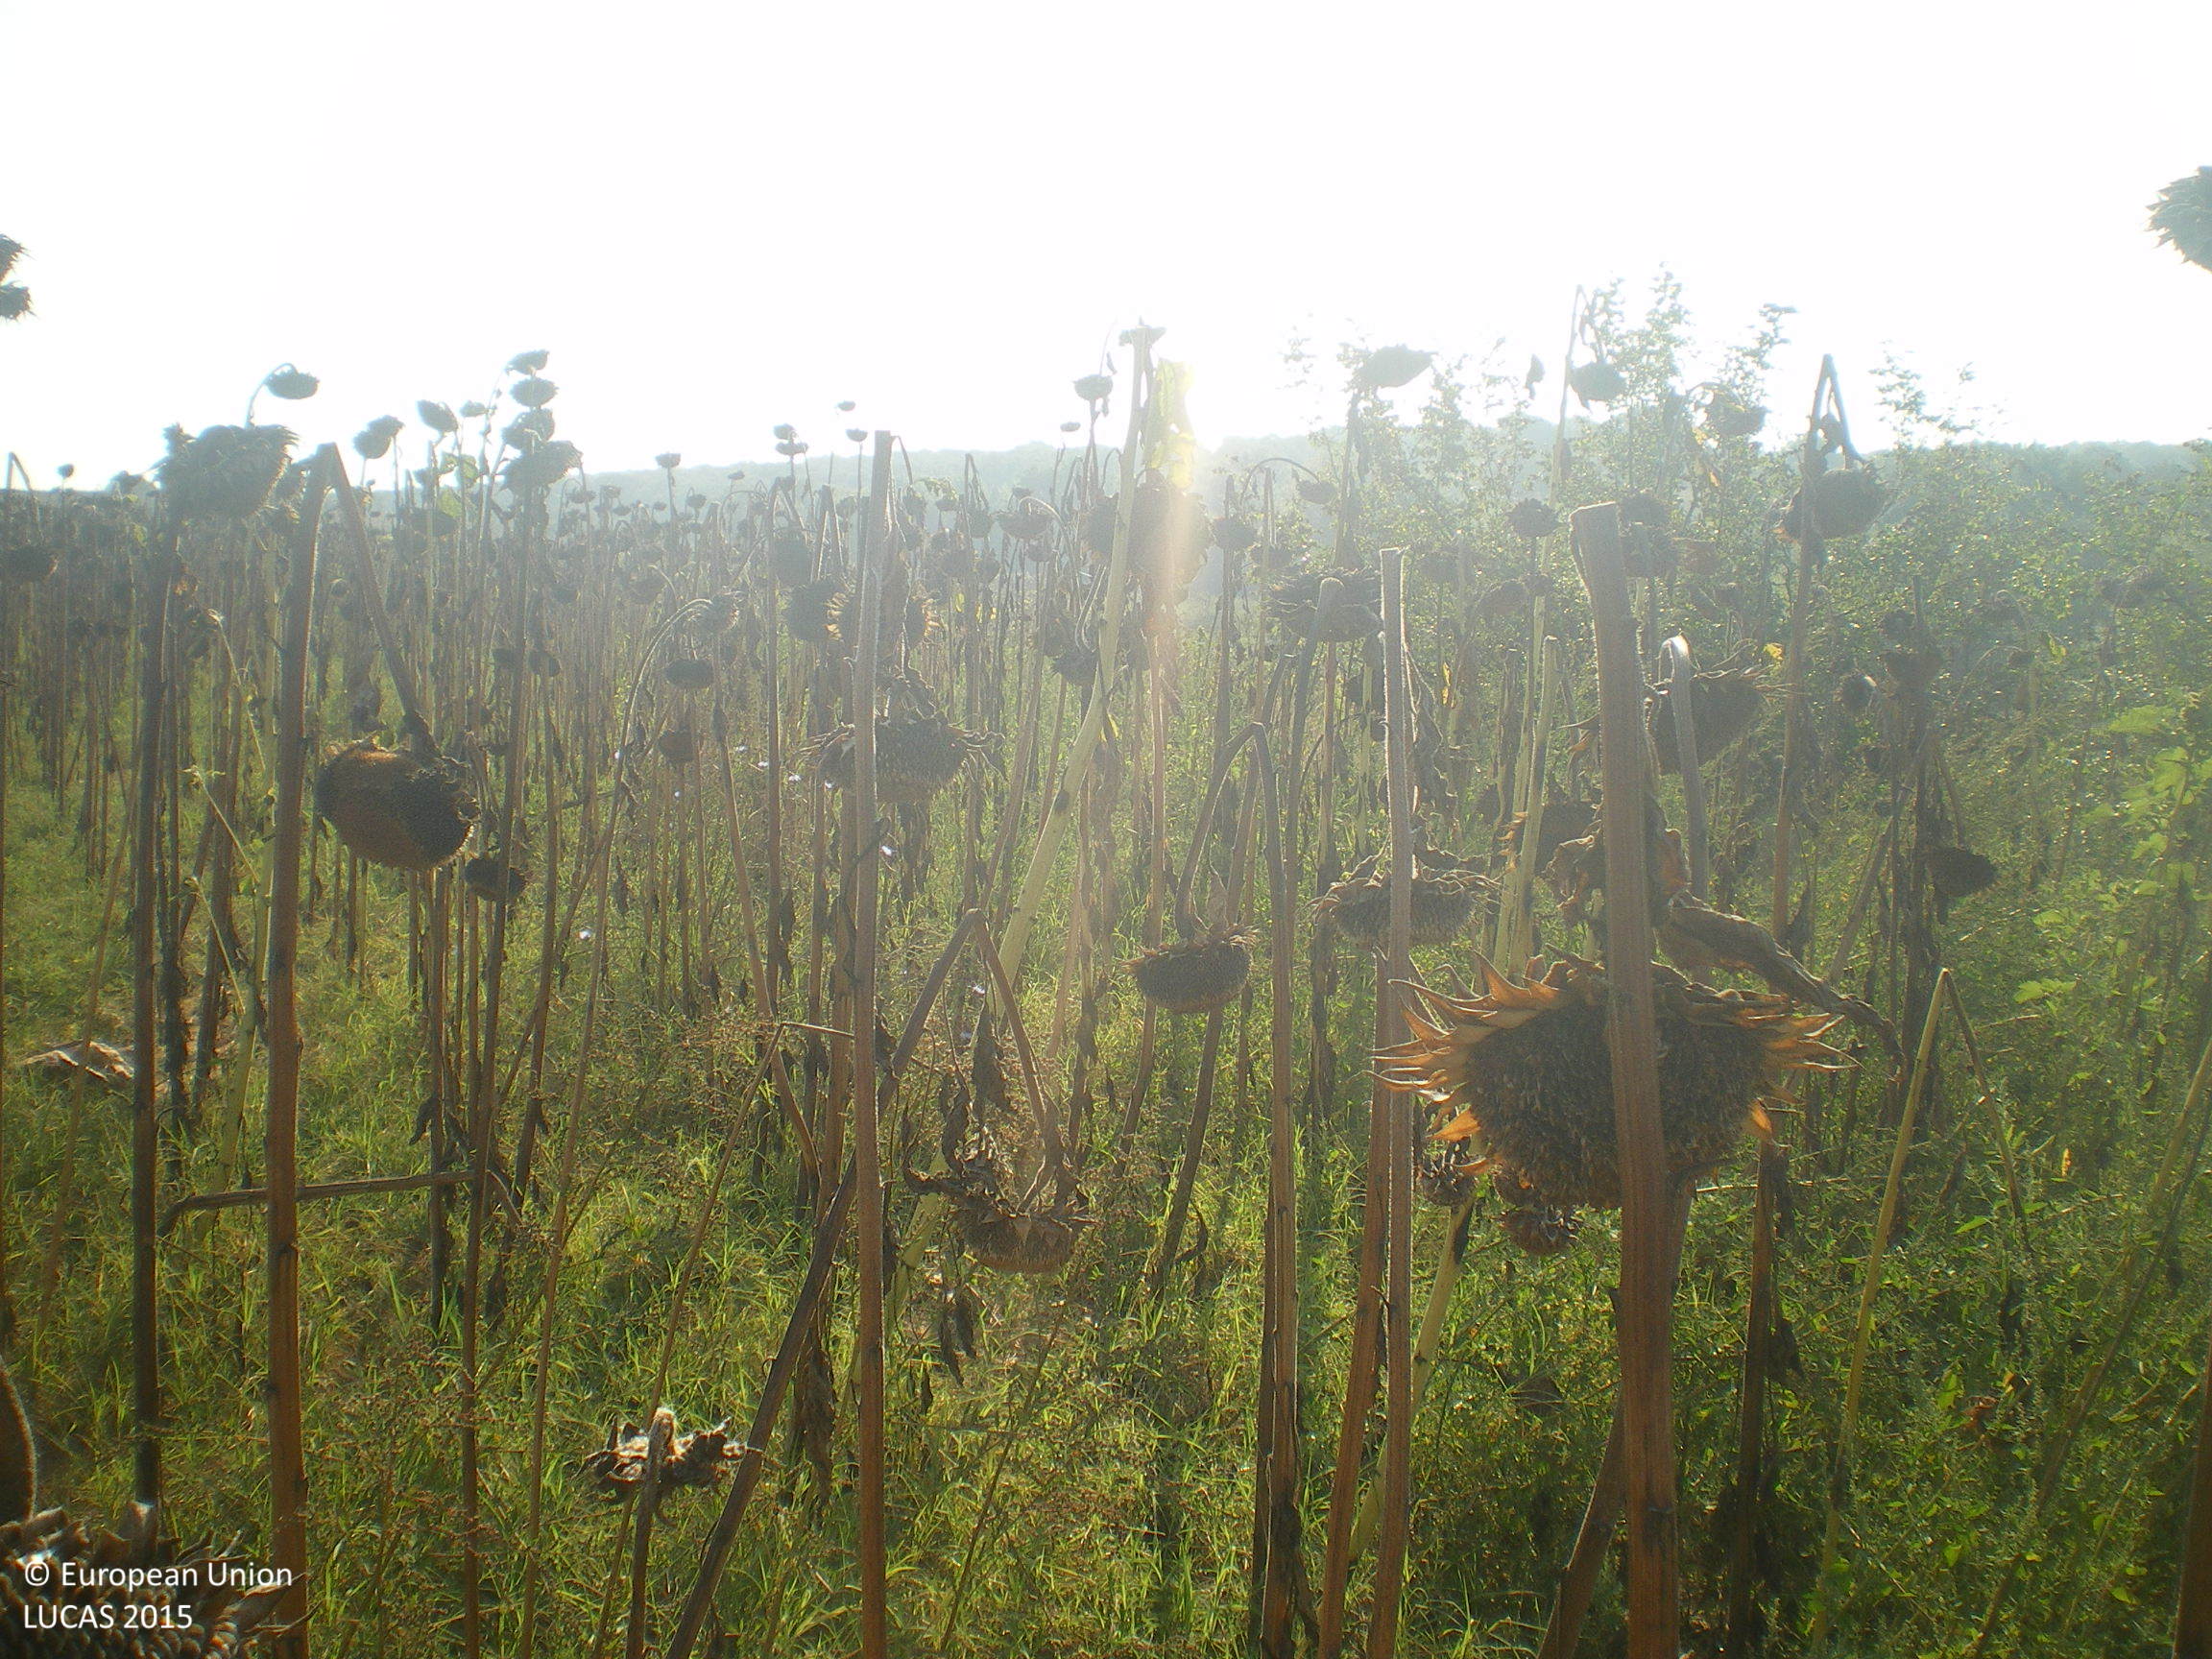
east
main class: Cropland
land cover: Sunflower
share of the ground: > 75 %
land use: Agriculture (excluding fallow land and kitchen gardens)
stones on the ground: > 50 %
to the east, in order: Sunflower; Spontaneously vegetated surfaces; Sunflower
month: August
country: BG
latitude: 42.0266
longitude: 25.9315
